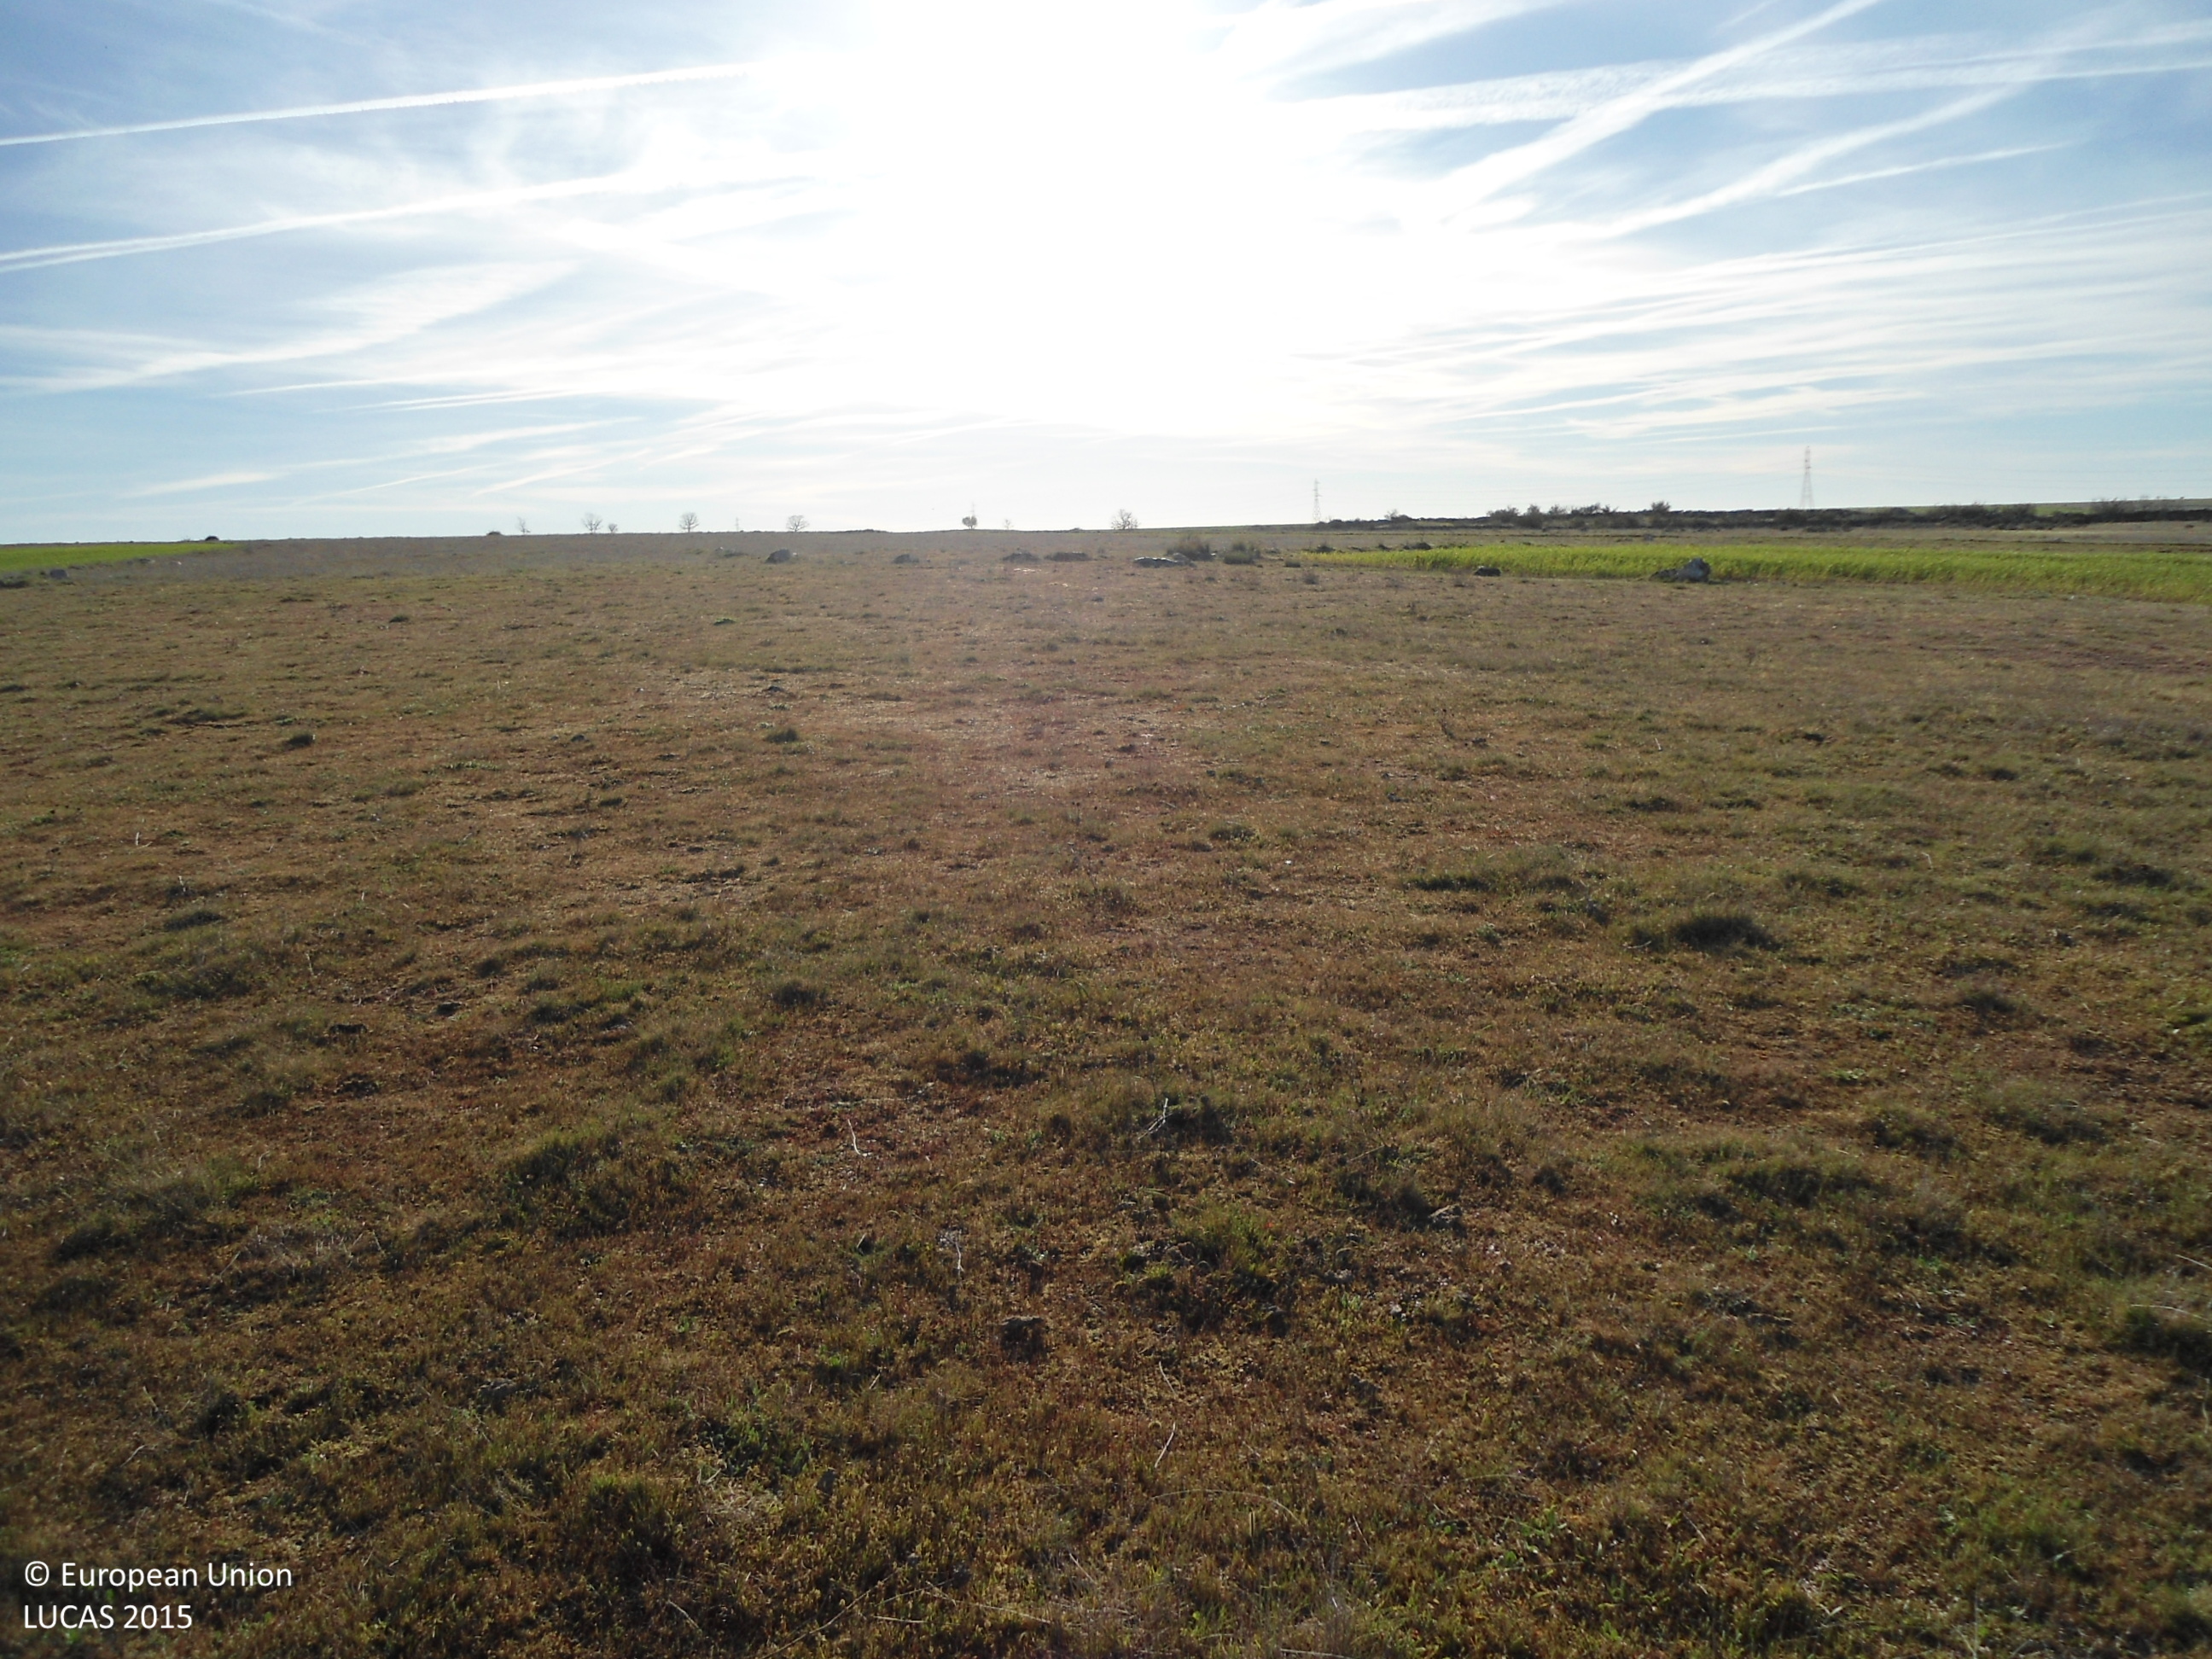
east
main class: Grassland
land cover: Grassland without tree/shrub cover
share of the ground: > 75 %
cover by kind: herbaceous plants 100 %
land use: Agriculture (excluding fallow land and kitchen gardens)
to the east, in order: Grassland without tree/shrub cover; Common wheat; Grass margins; Common wheat; Grassland without tree/shrub cover
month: April
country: ES
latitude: 41.5481
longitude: -6.0499
